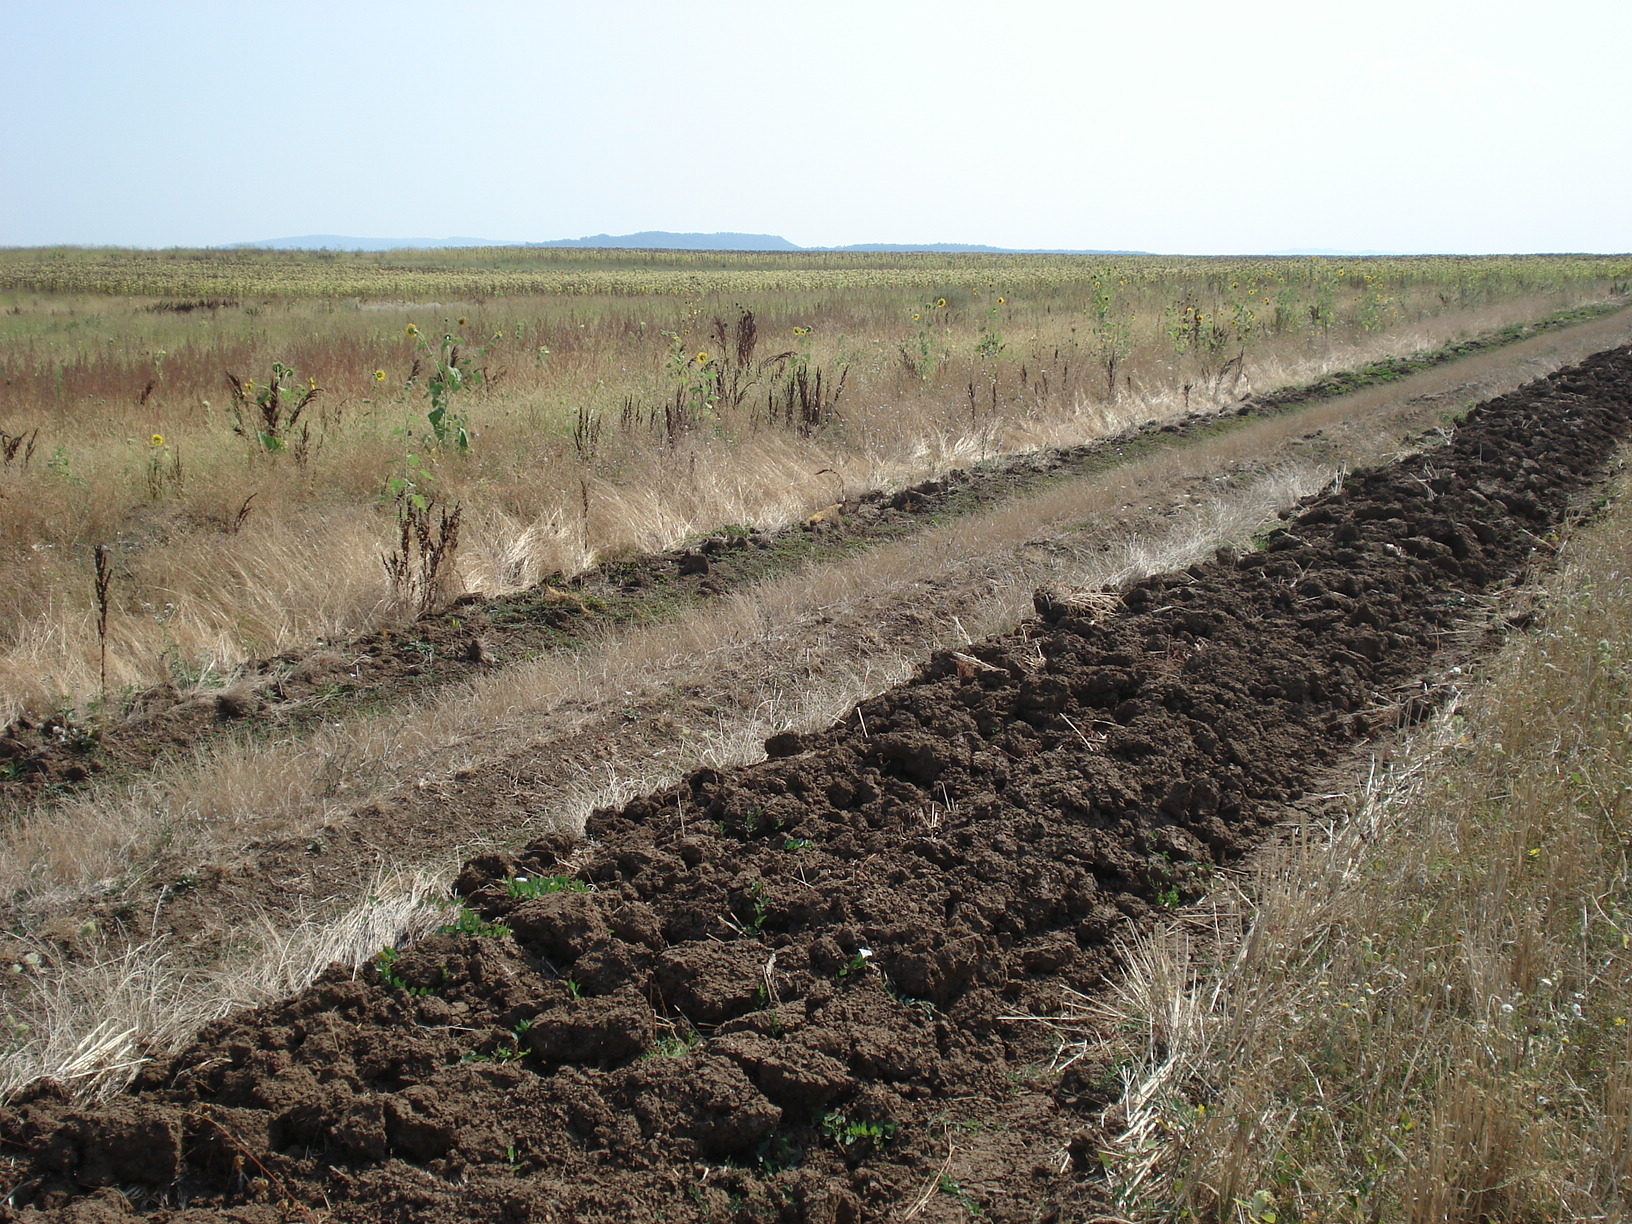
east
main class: Cropland
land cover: Common wheat
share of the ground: 50 - 75 %
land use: Agriculture (excluding fallow land and kitchen gardens)
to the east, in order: Common wheat; Tracks; Grassland without tree/shrub cover; Sunflower; Grassland without tree/shrub cover; Sunflower
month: August
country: BG
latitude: 43.0808
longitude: 25.7679
